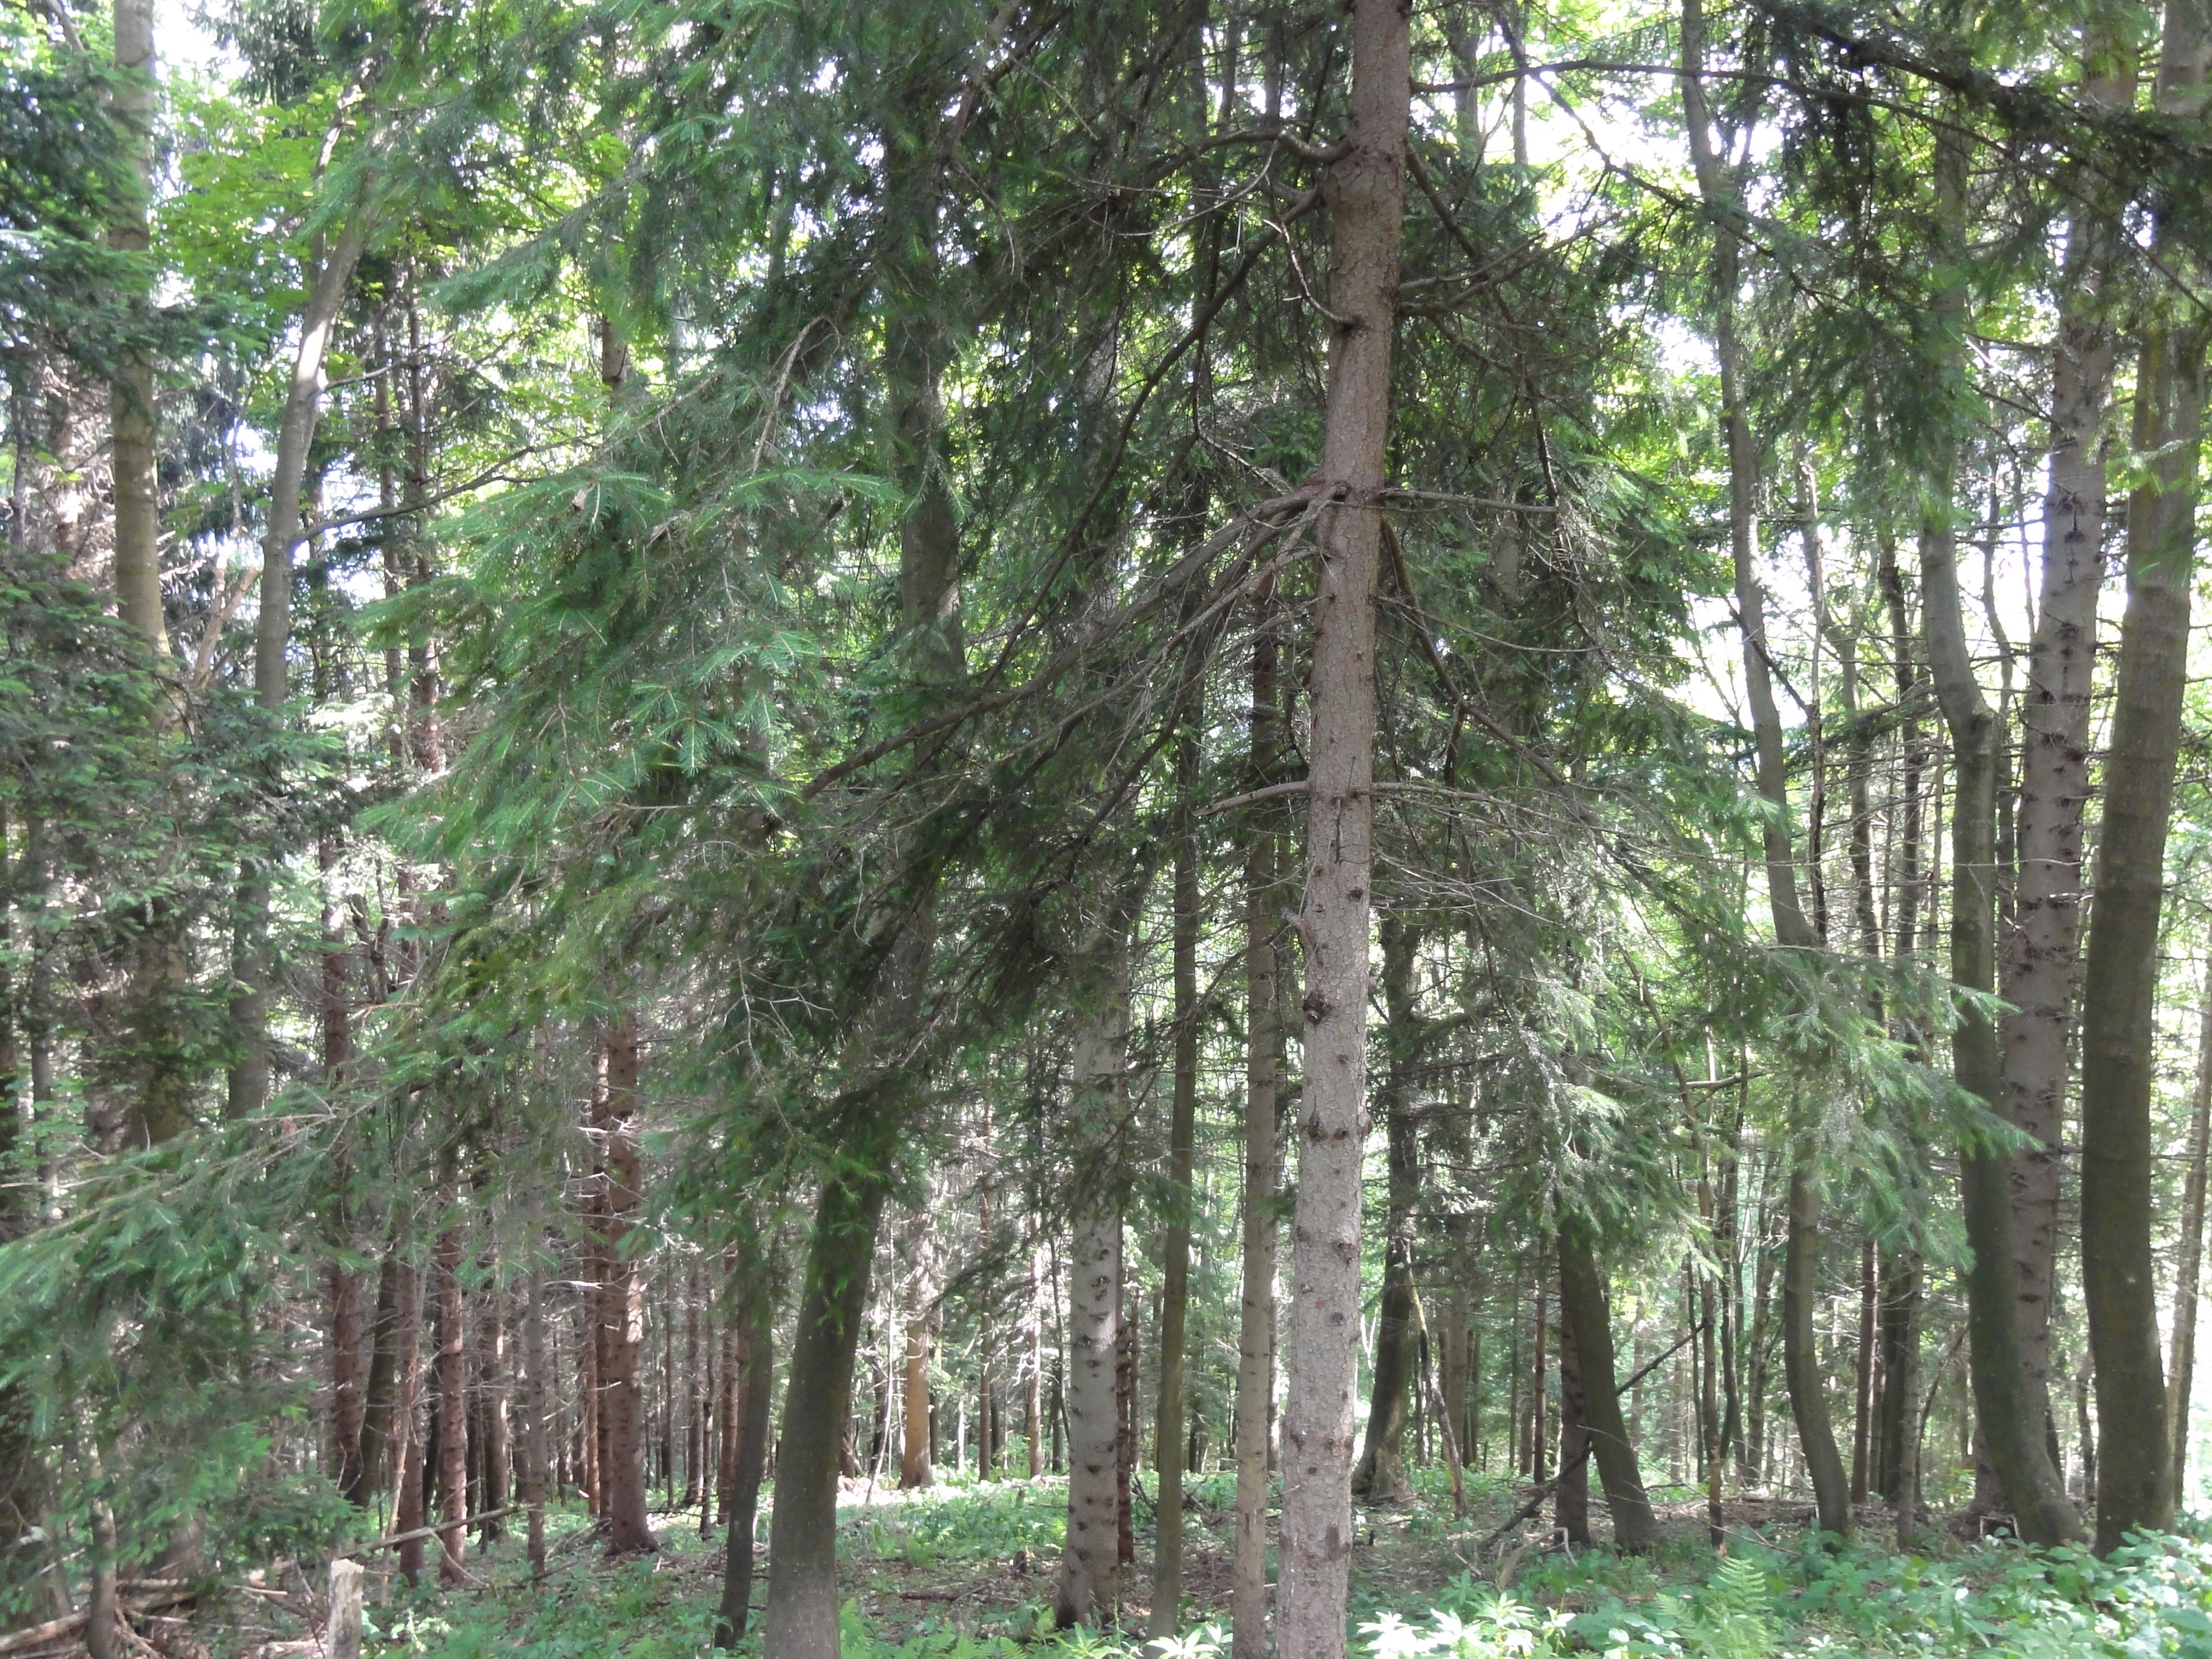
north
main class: Woodland
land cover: Spruce dominated mixed woodland
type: mountainous beech forest
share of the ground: > 75 %
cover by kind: coniferous forest trees 50 %, broadleaved forest trees 50 %
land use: Forestry
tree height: > 5 m
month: June
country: SI
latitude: 46.2132
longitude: 15.0656
